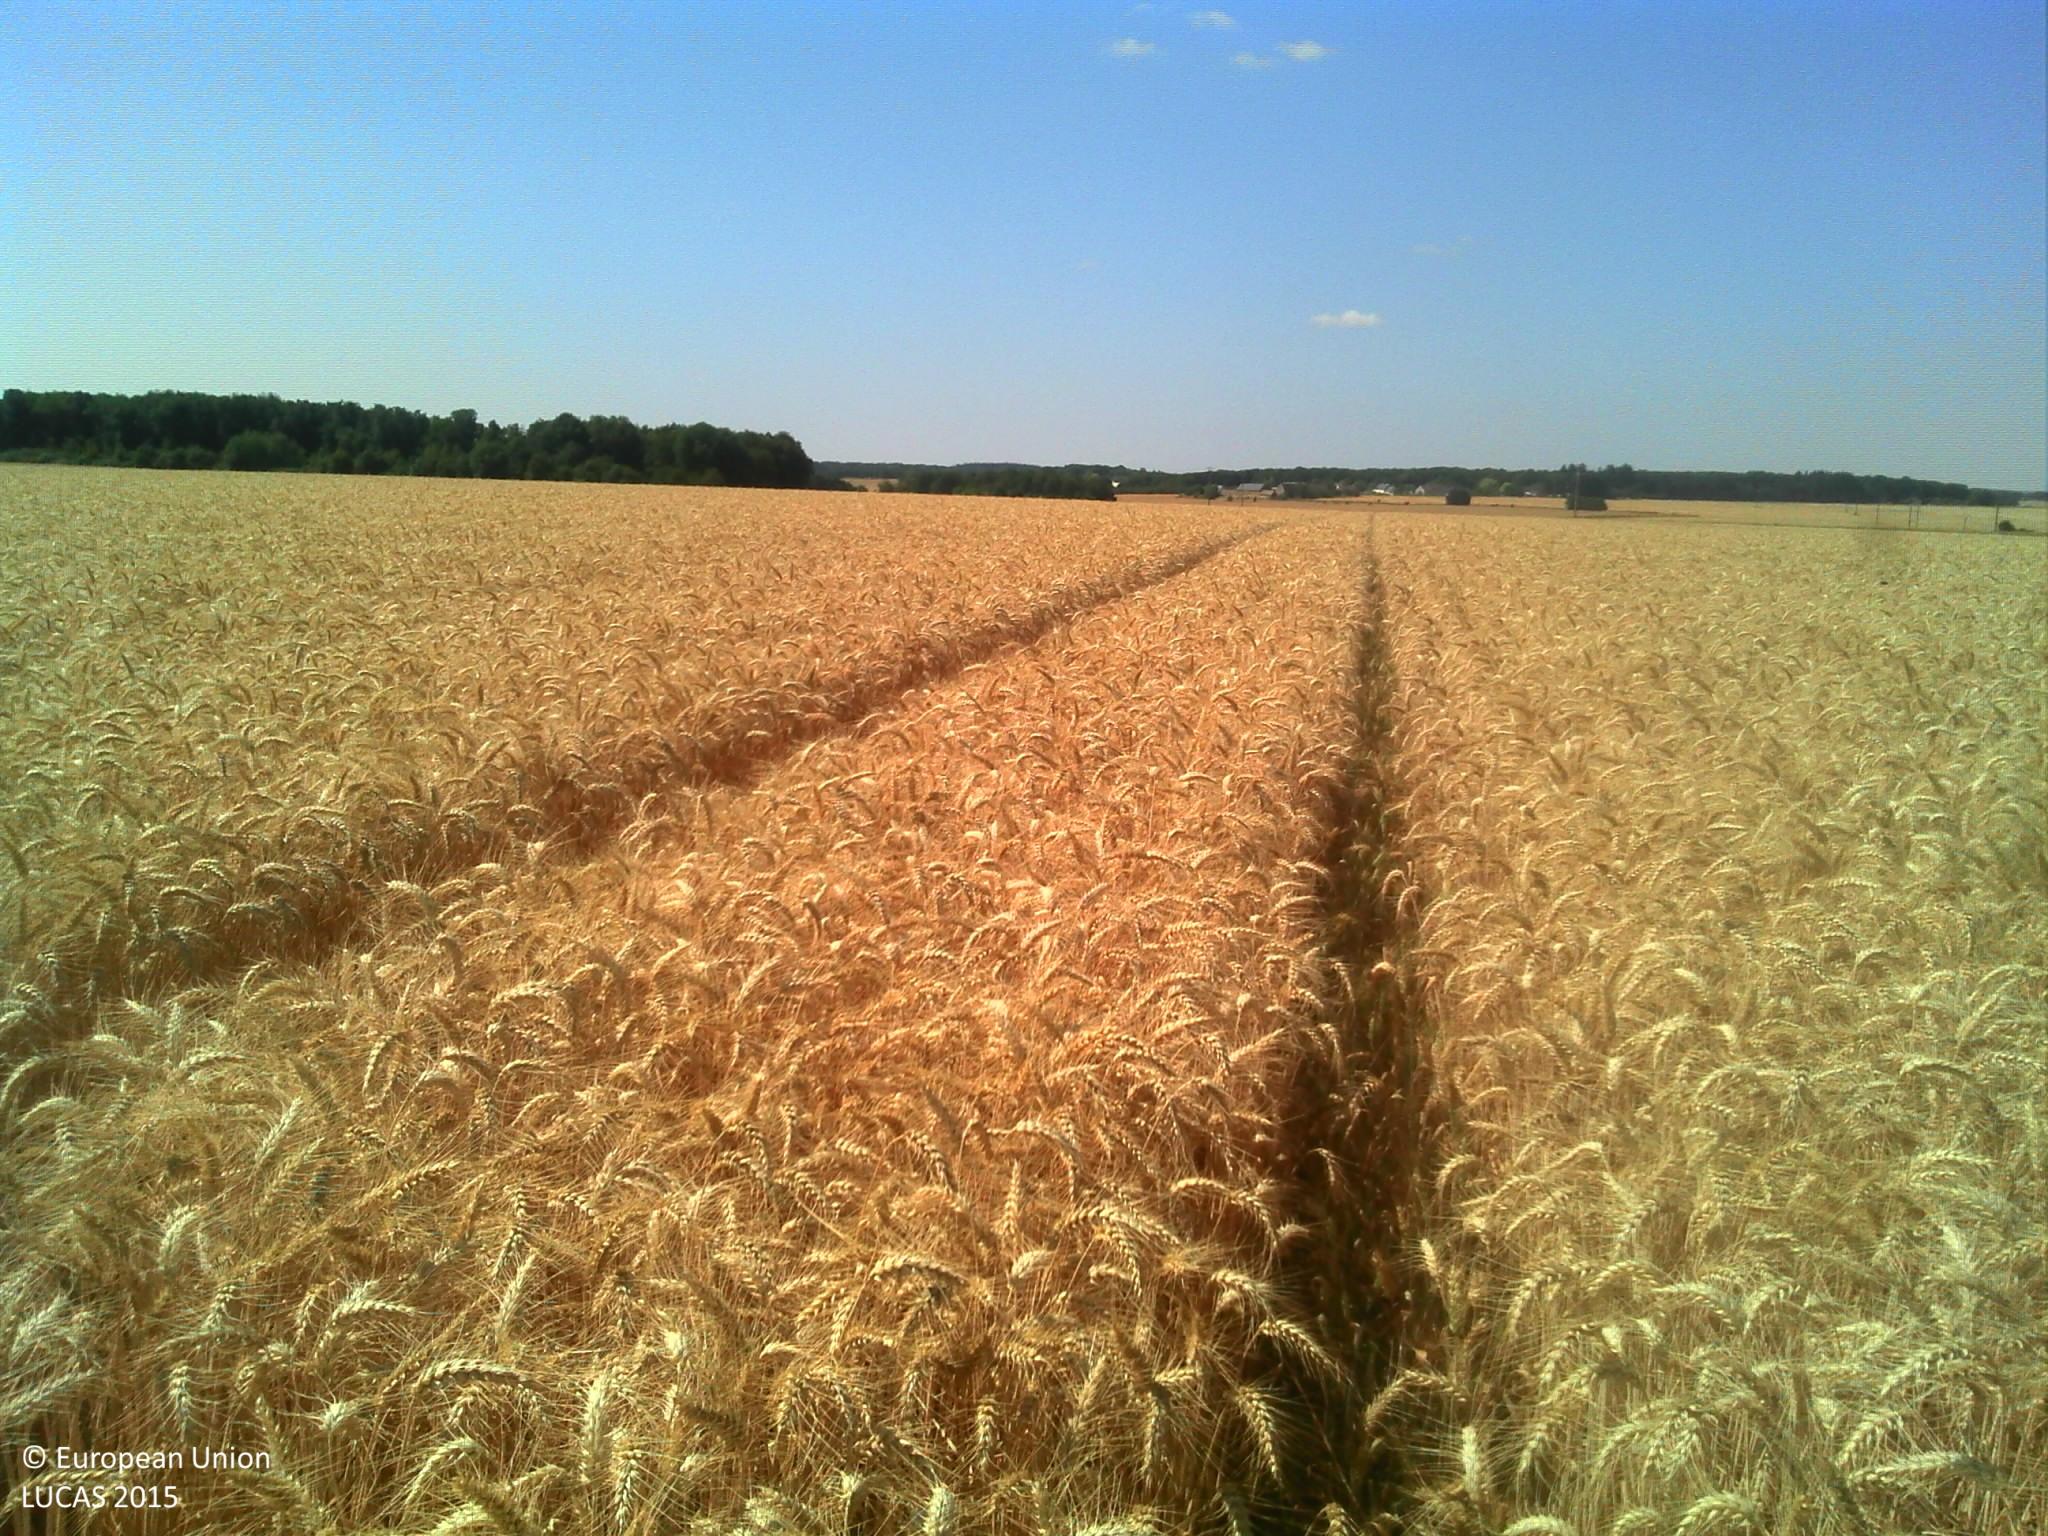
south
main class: Cropland
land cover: Common wheat
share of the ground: > 75 %
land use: Agriculture (excluding fallow land and kitchen gardens)
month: July
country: FR
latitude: 48.1137
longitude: 1.2921
